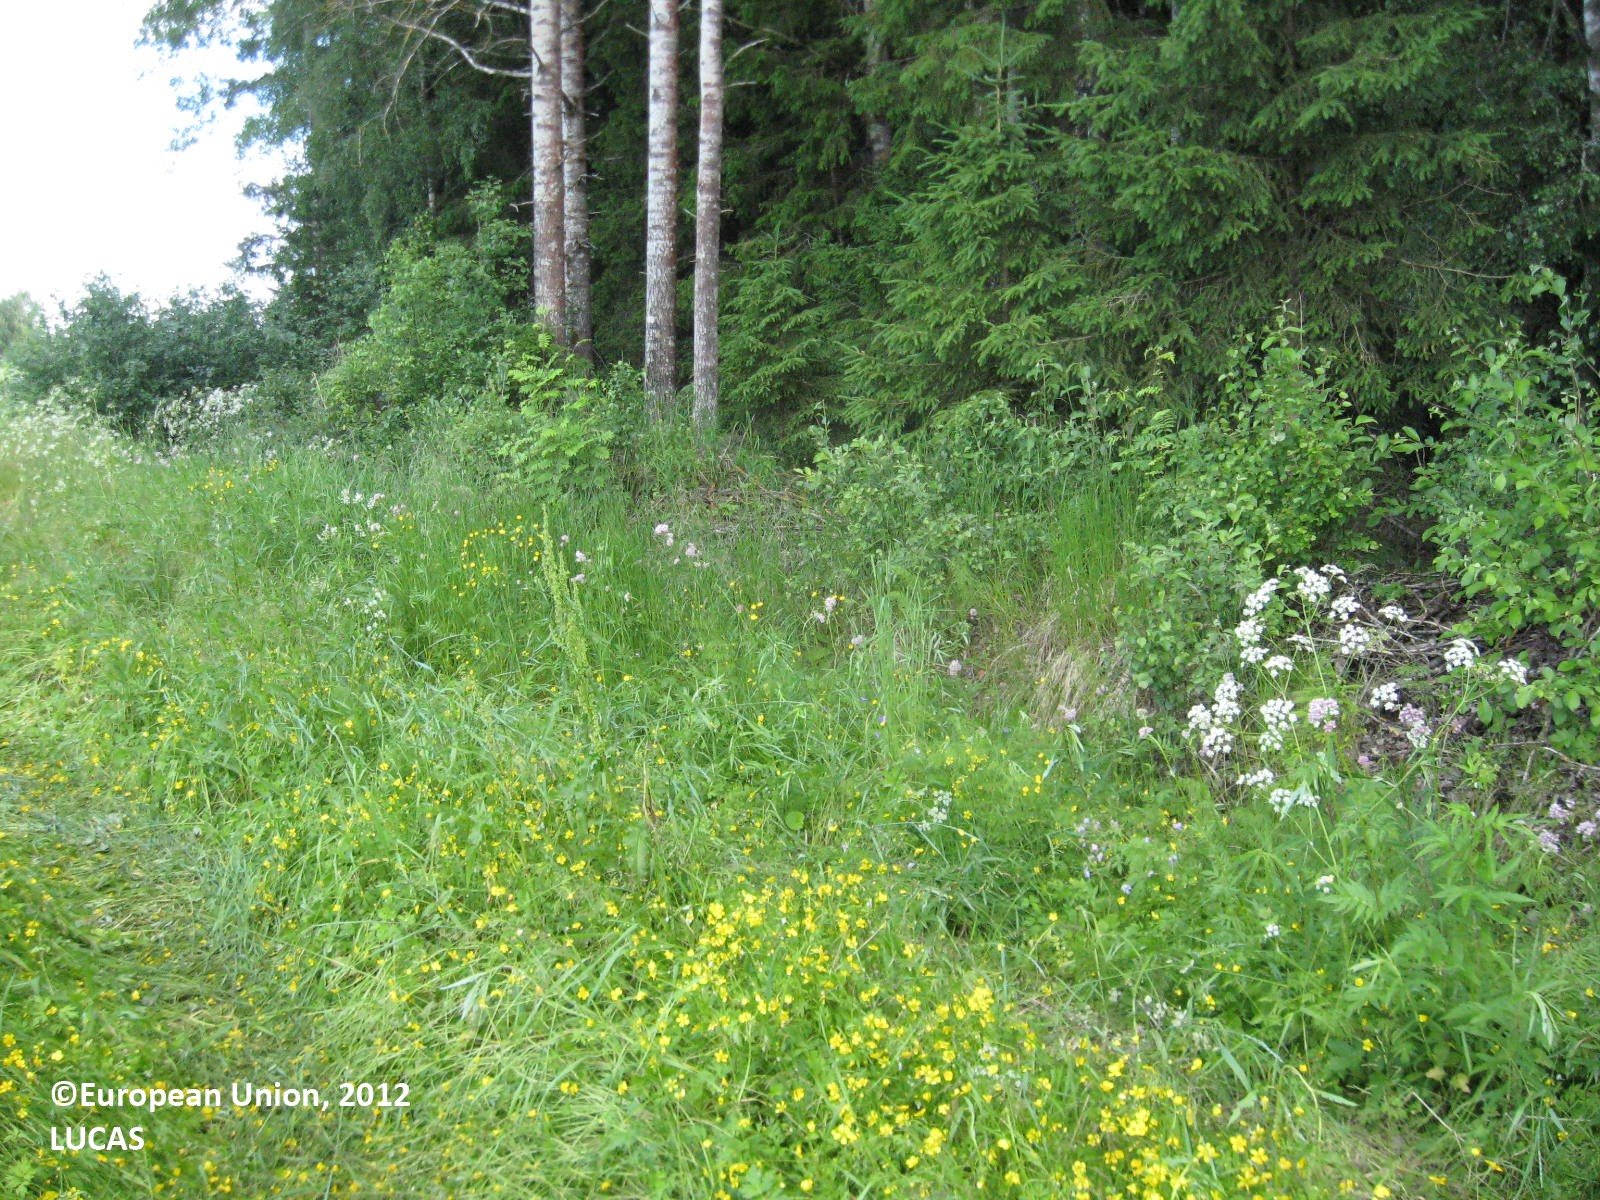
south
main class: Grassland
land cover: Grassland without tree/shrub cover
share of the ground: > 75 %
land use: Agriculture (excluding fallow land and kitchen gardens)
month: July
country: FI
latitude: 62.5499
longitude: 22.6776
